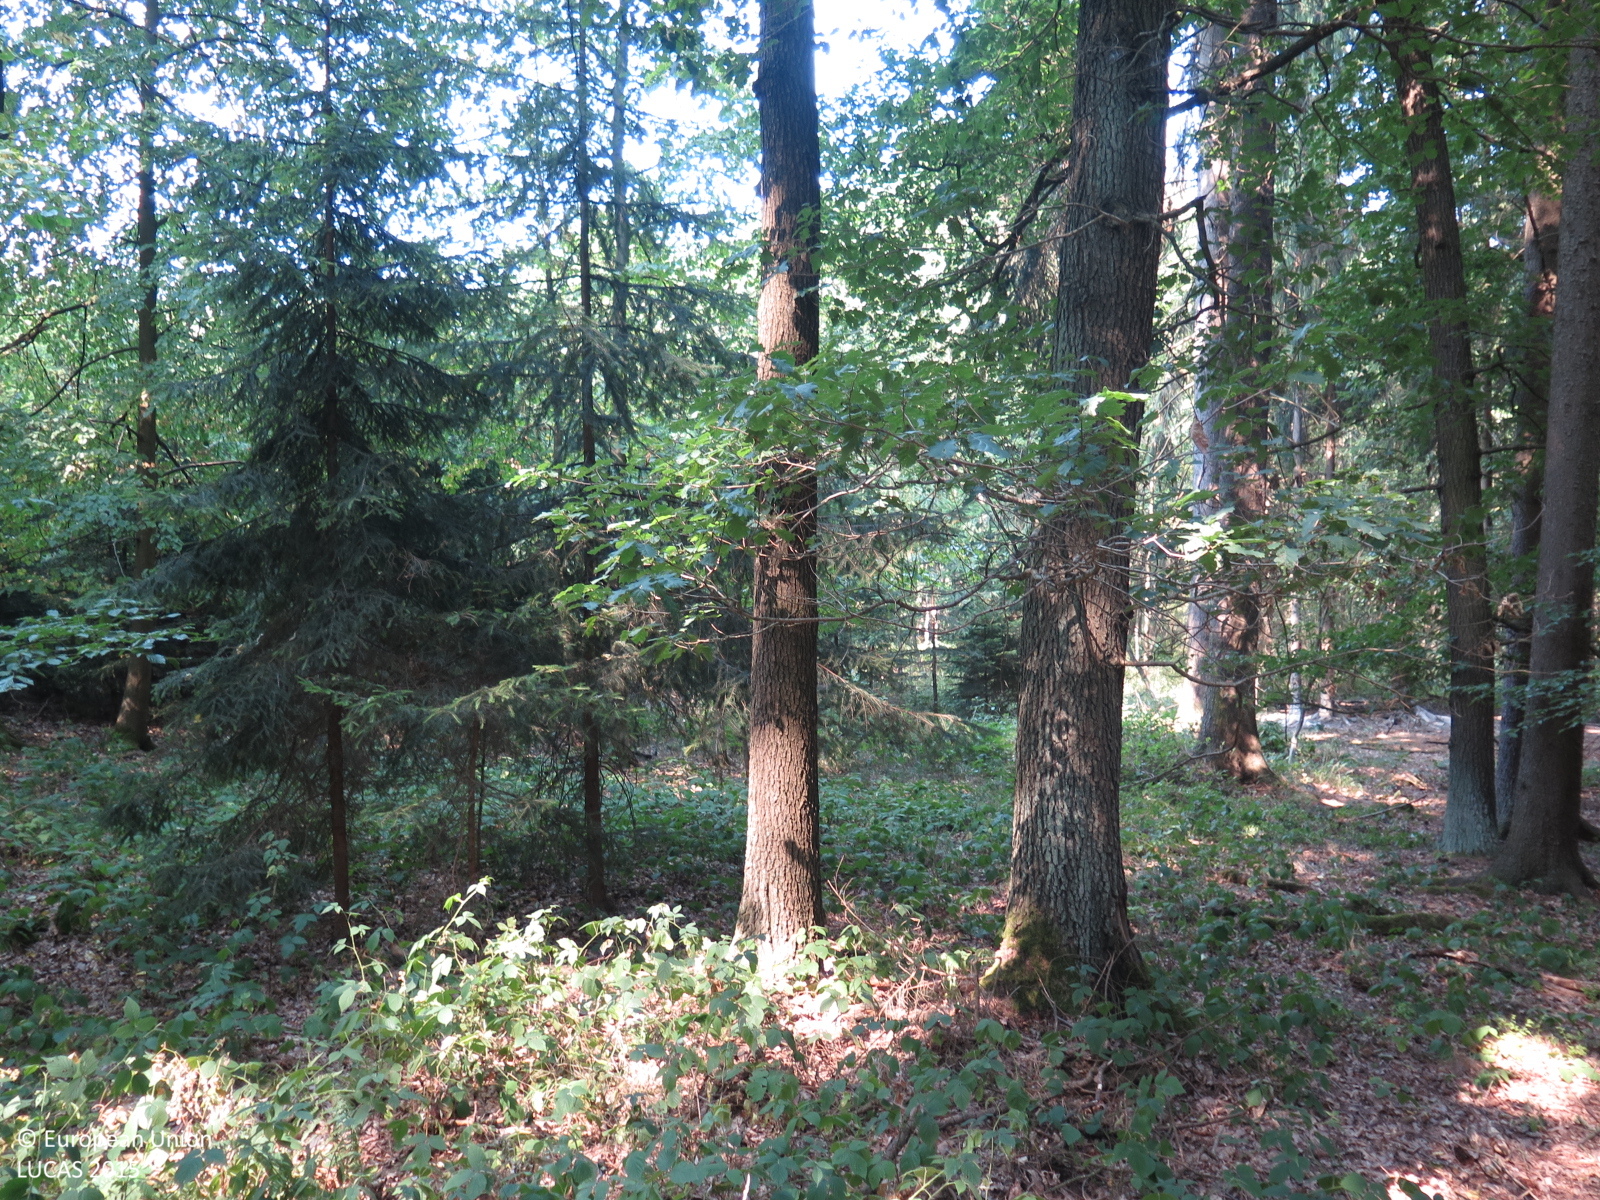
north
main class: Woodland
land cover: Spruce dominated mixed woodland
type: hemiboreal forest and nemoral coniferous forest and mixed broadleaved-coniferous forest
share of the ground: > 75 %
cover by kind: coniferous forest trees 65 %, broadleaved forest trees 30 %, herbaceous plants 5 %
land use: Forestry
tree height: > 5 m
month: August
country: CZ
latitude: 49.8860
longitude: 13.8281
